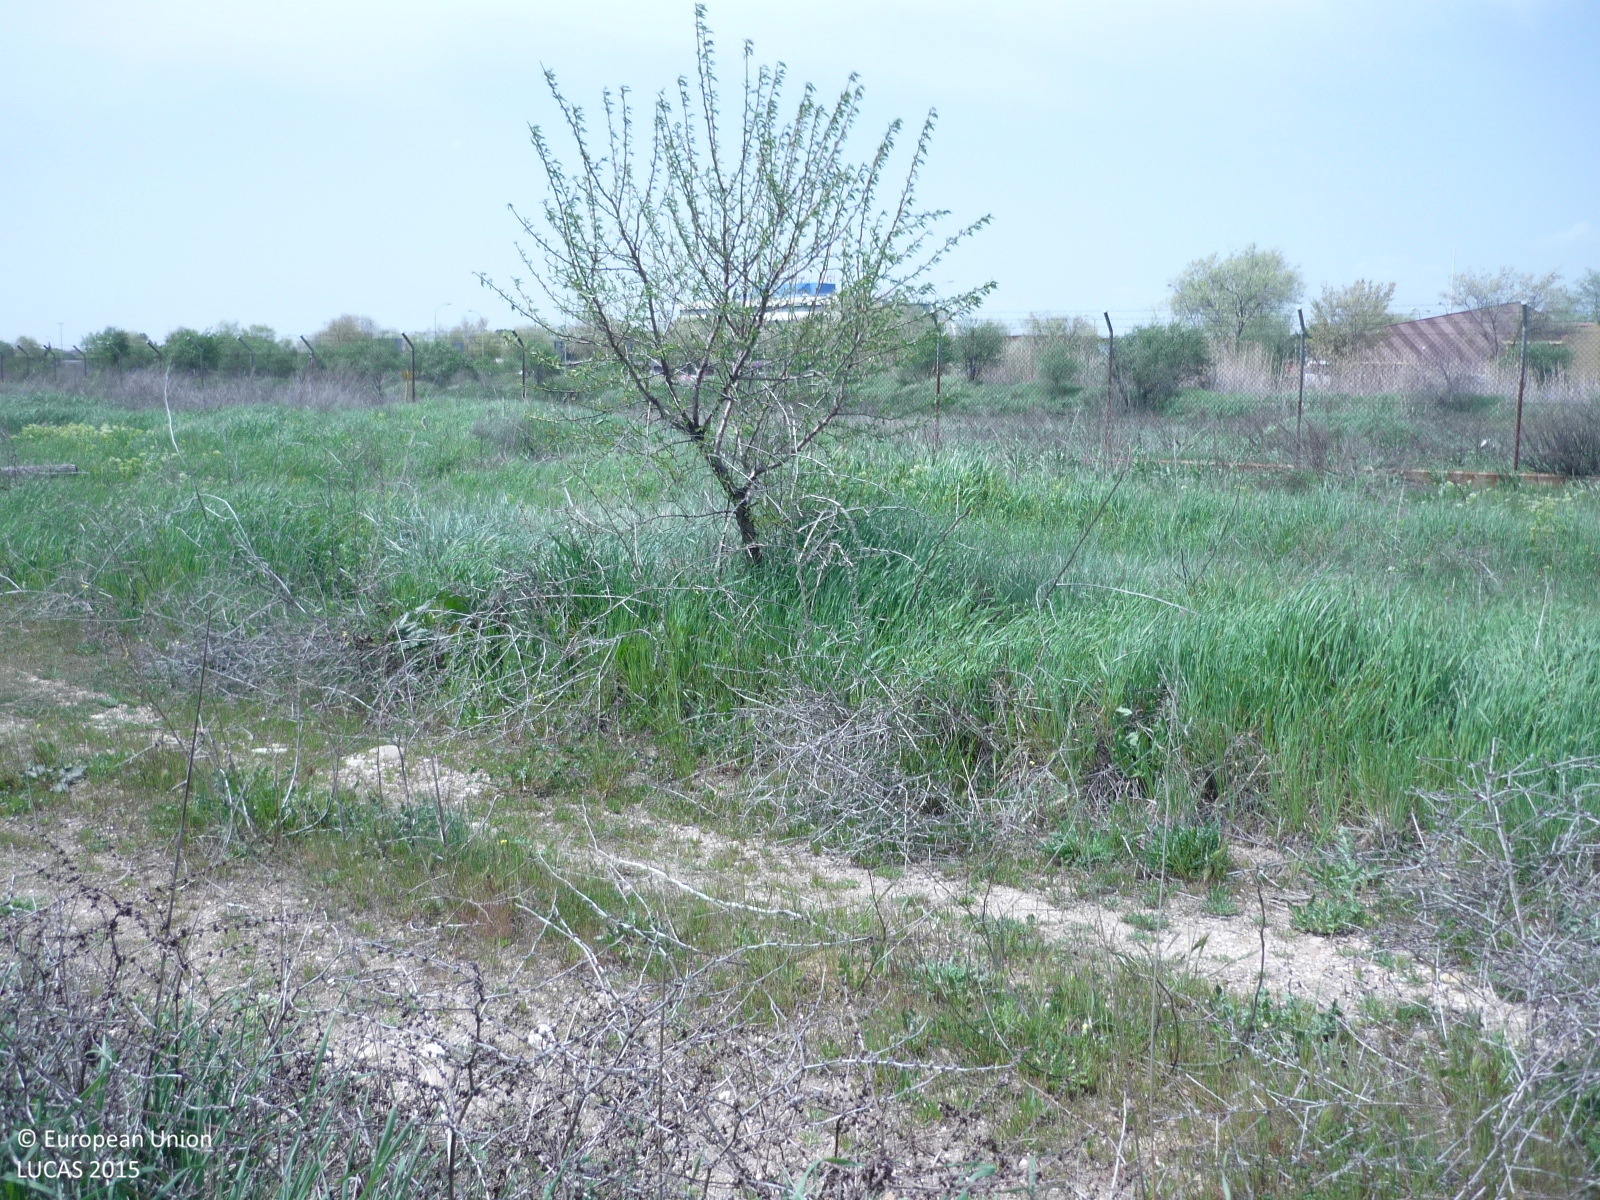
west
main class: Grassland
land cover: Grassland without tree/shrub cover
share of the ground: > 75 %
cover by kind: herbaceous plants 80 %, consolidated bare surface 20 %
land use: Abandoned areas
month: April
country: ES
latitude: 40.4724
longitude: -3.4457
